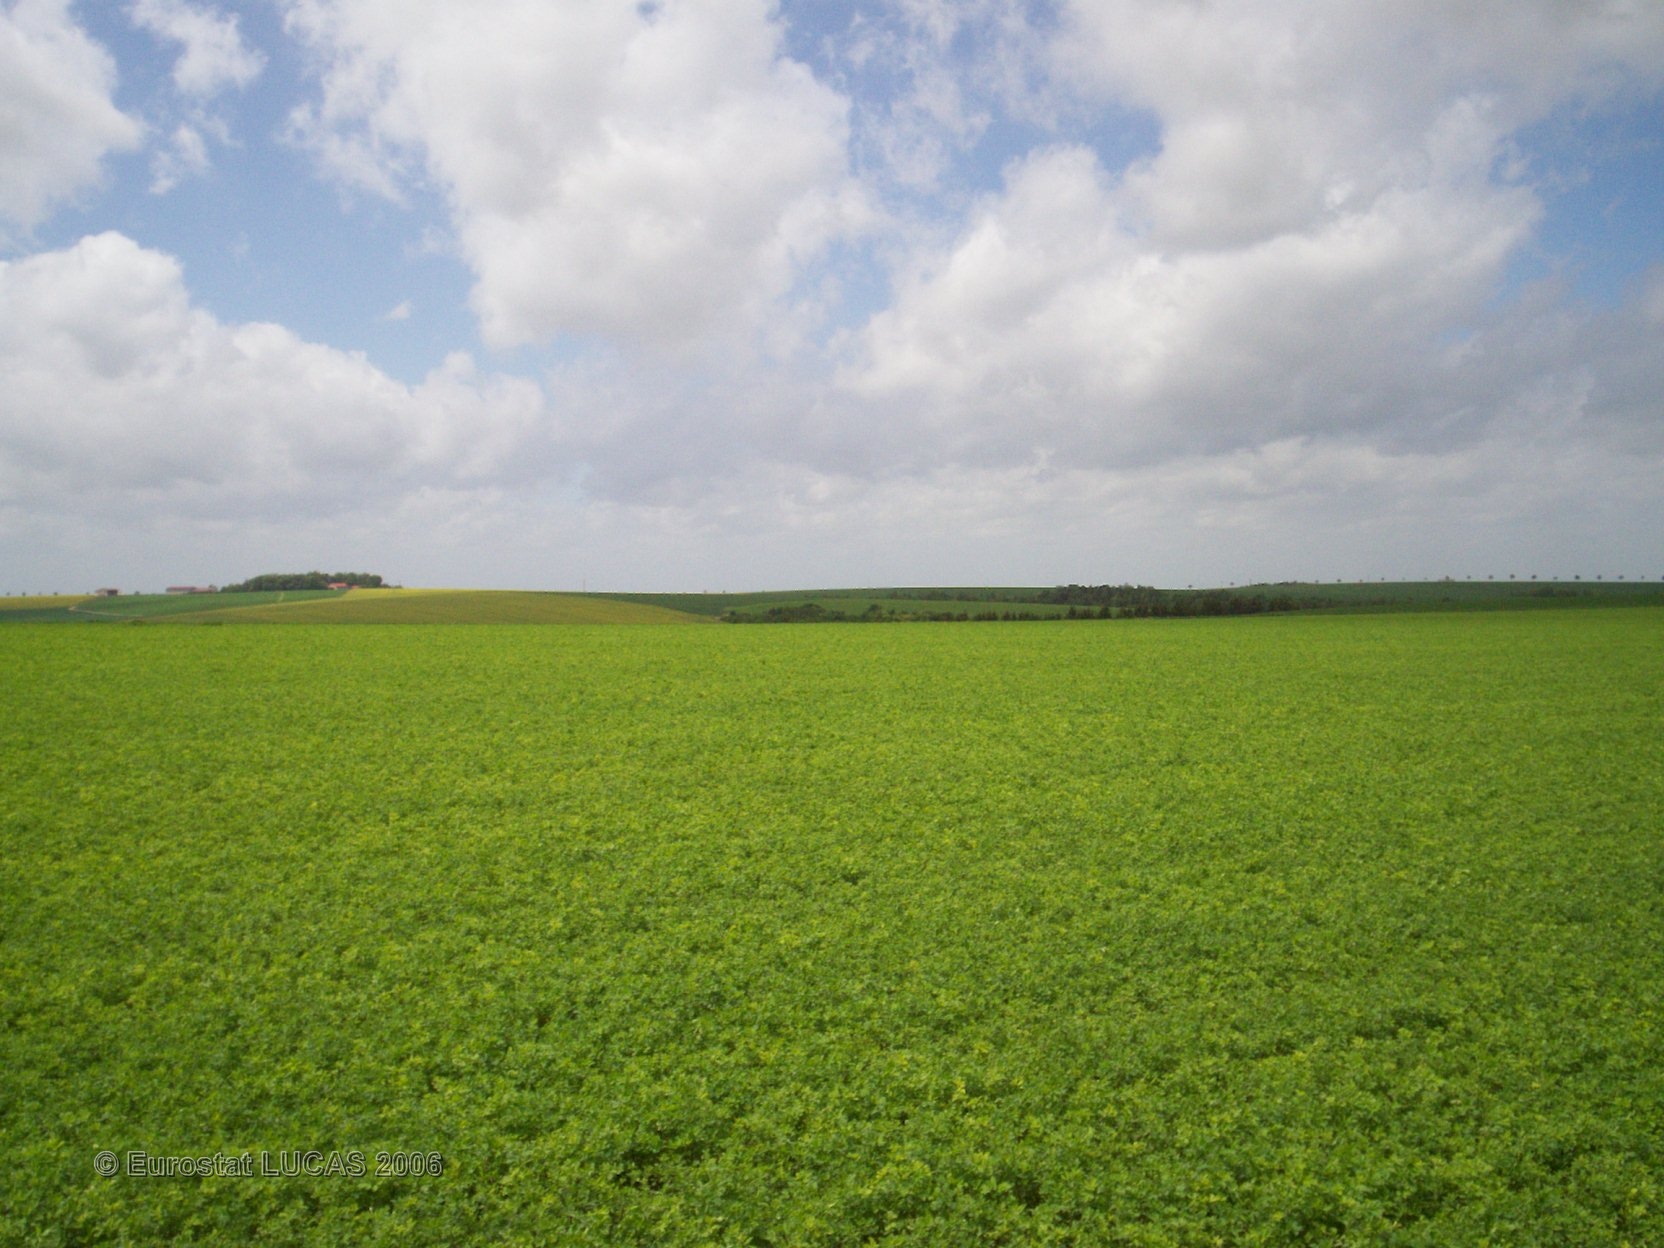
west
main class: Cropland
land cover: Lucerne
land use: Agriculture (excluding fallow land and kitchen gardens)
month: May
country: FR
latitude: 49.3168
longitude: 4.5903
